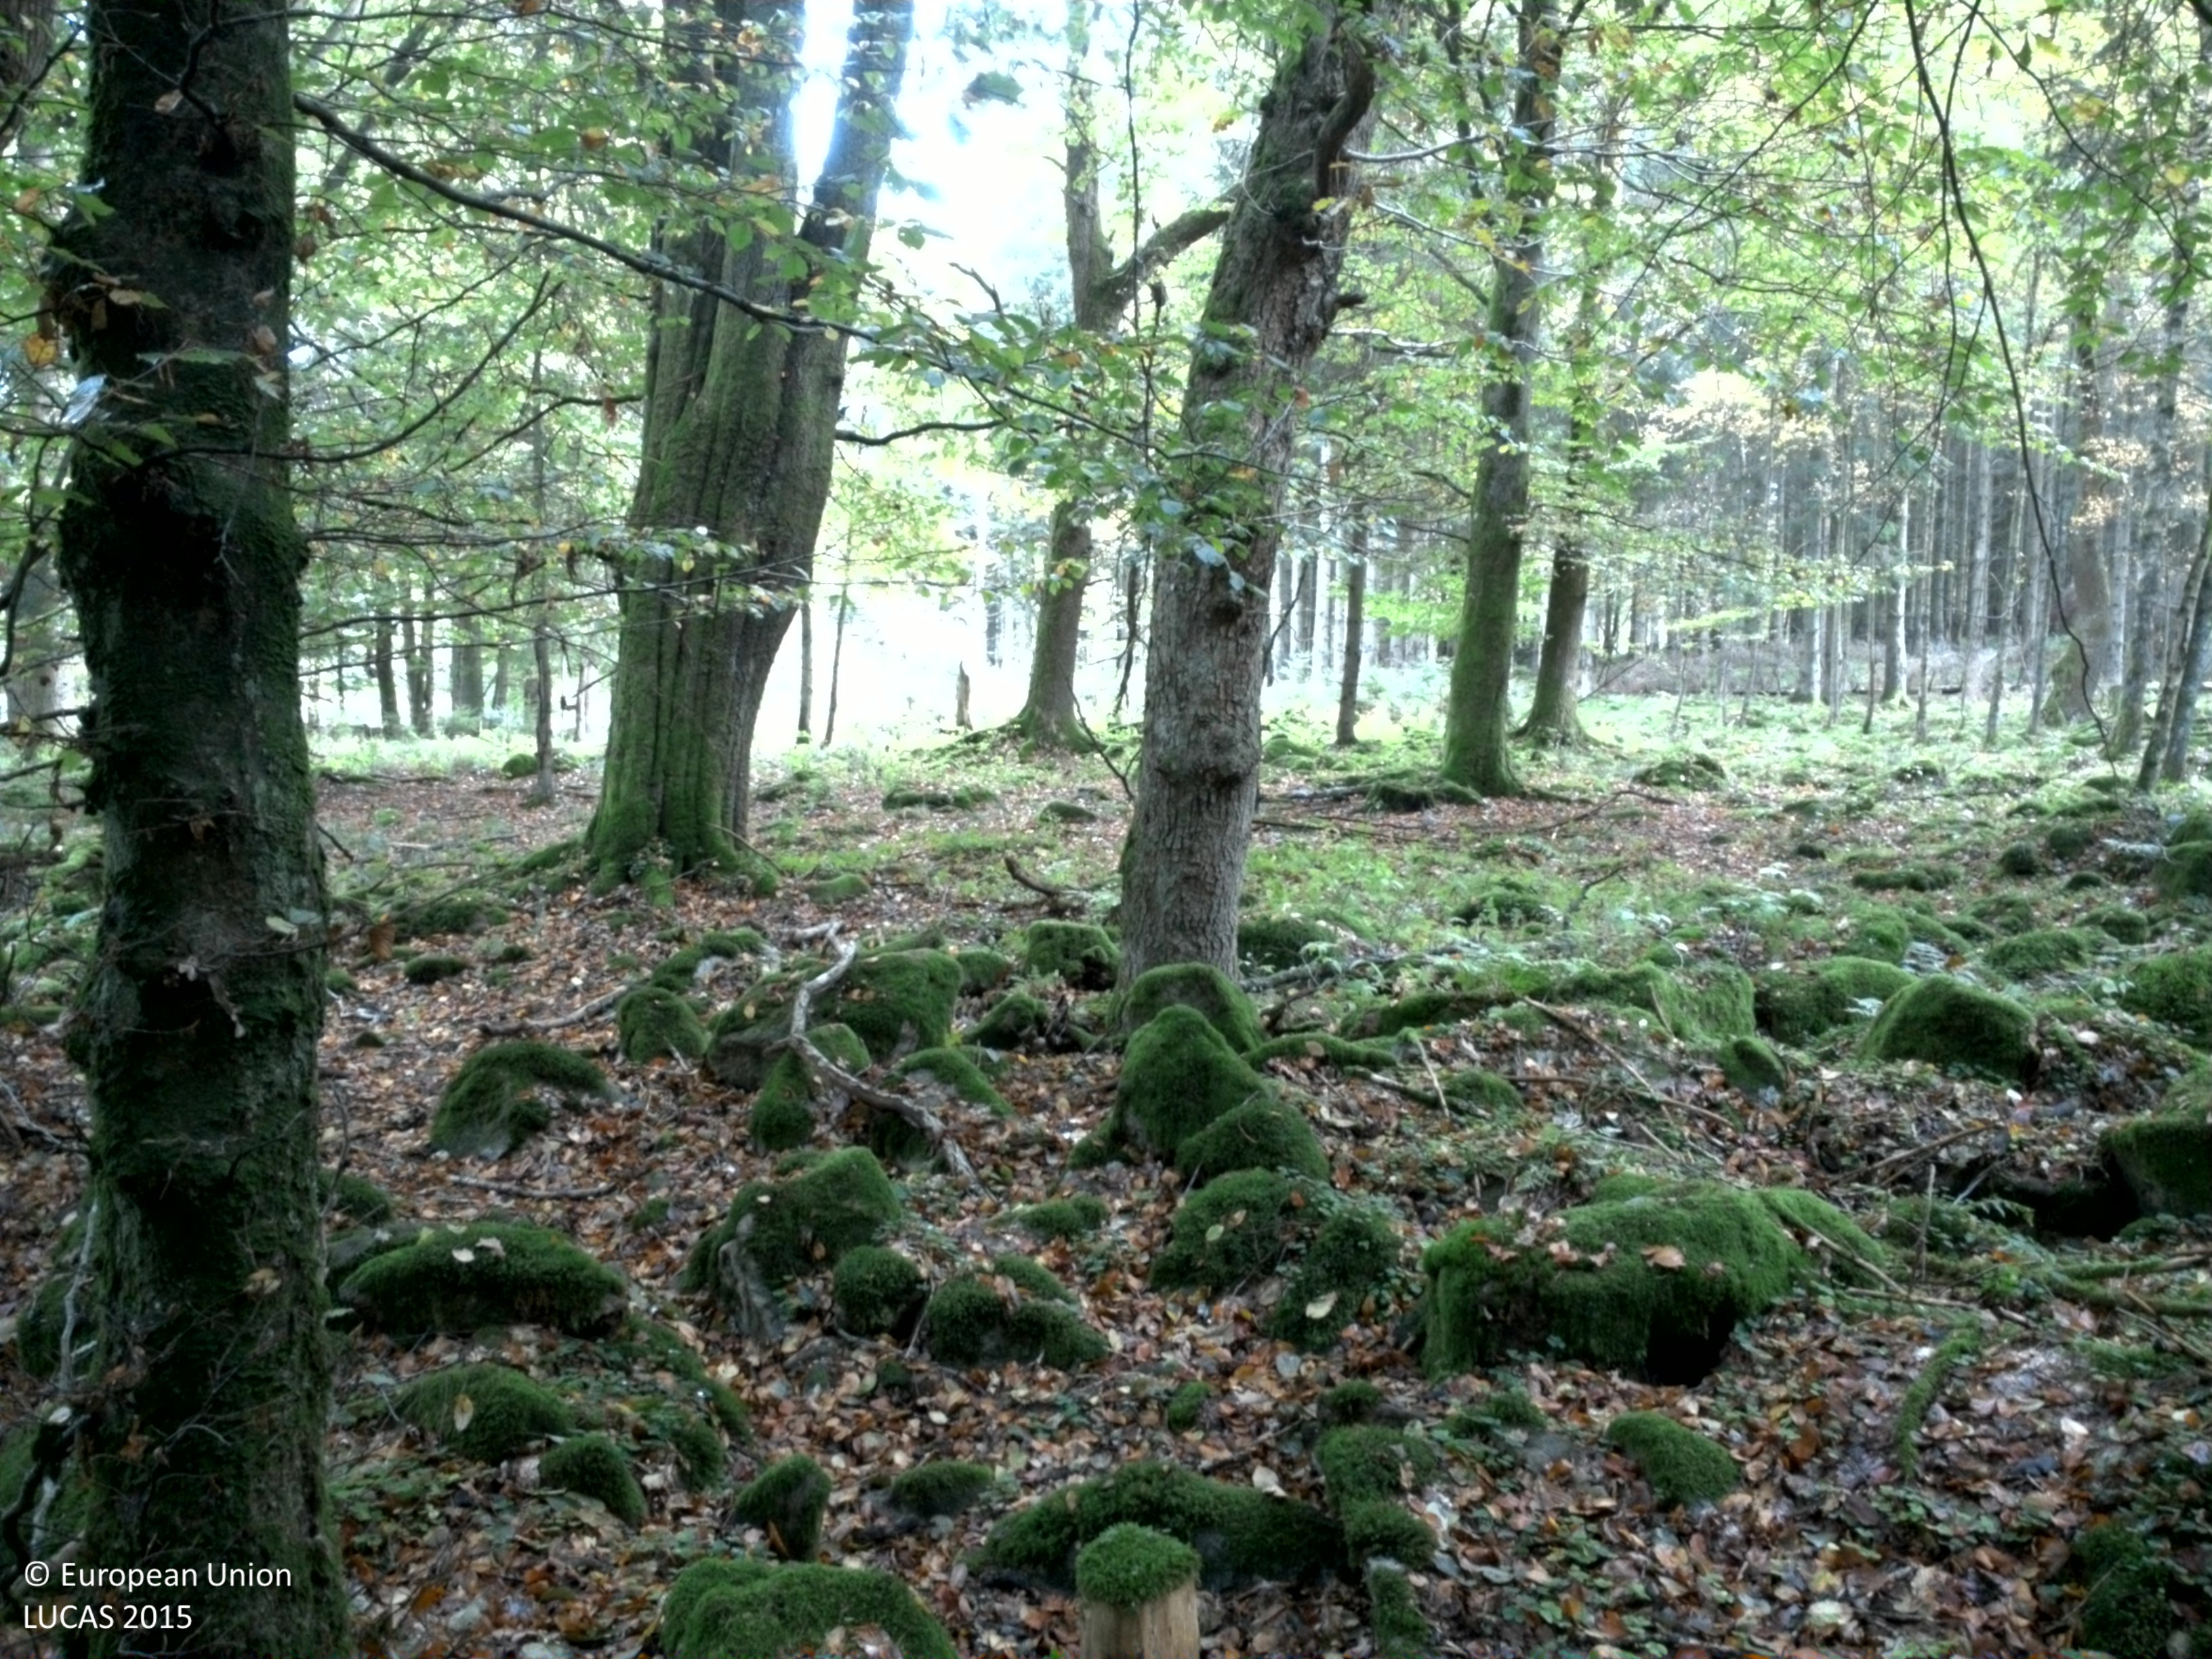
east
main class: Woodland
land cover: Broadleaved woodland
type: mesophytic deciduous forest
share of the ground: > 75 %
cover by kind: broadleaved forest trees 75 %, coniferous forest trees 5 %, shrubs 5 %, herbaceous plants 5 %, lichens and mosses 5 %, unconsolidated bare surface 5 %
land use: Forestry
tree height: > 5 m
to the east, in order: Broadleaved woodland; Spruce dominated coniferous woodland; Dry stone walls; Broadleaved woodland; Dry stone walls; Broadleaved woodland
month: October
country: SE
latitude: 55.6938
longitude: 13.9914
